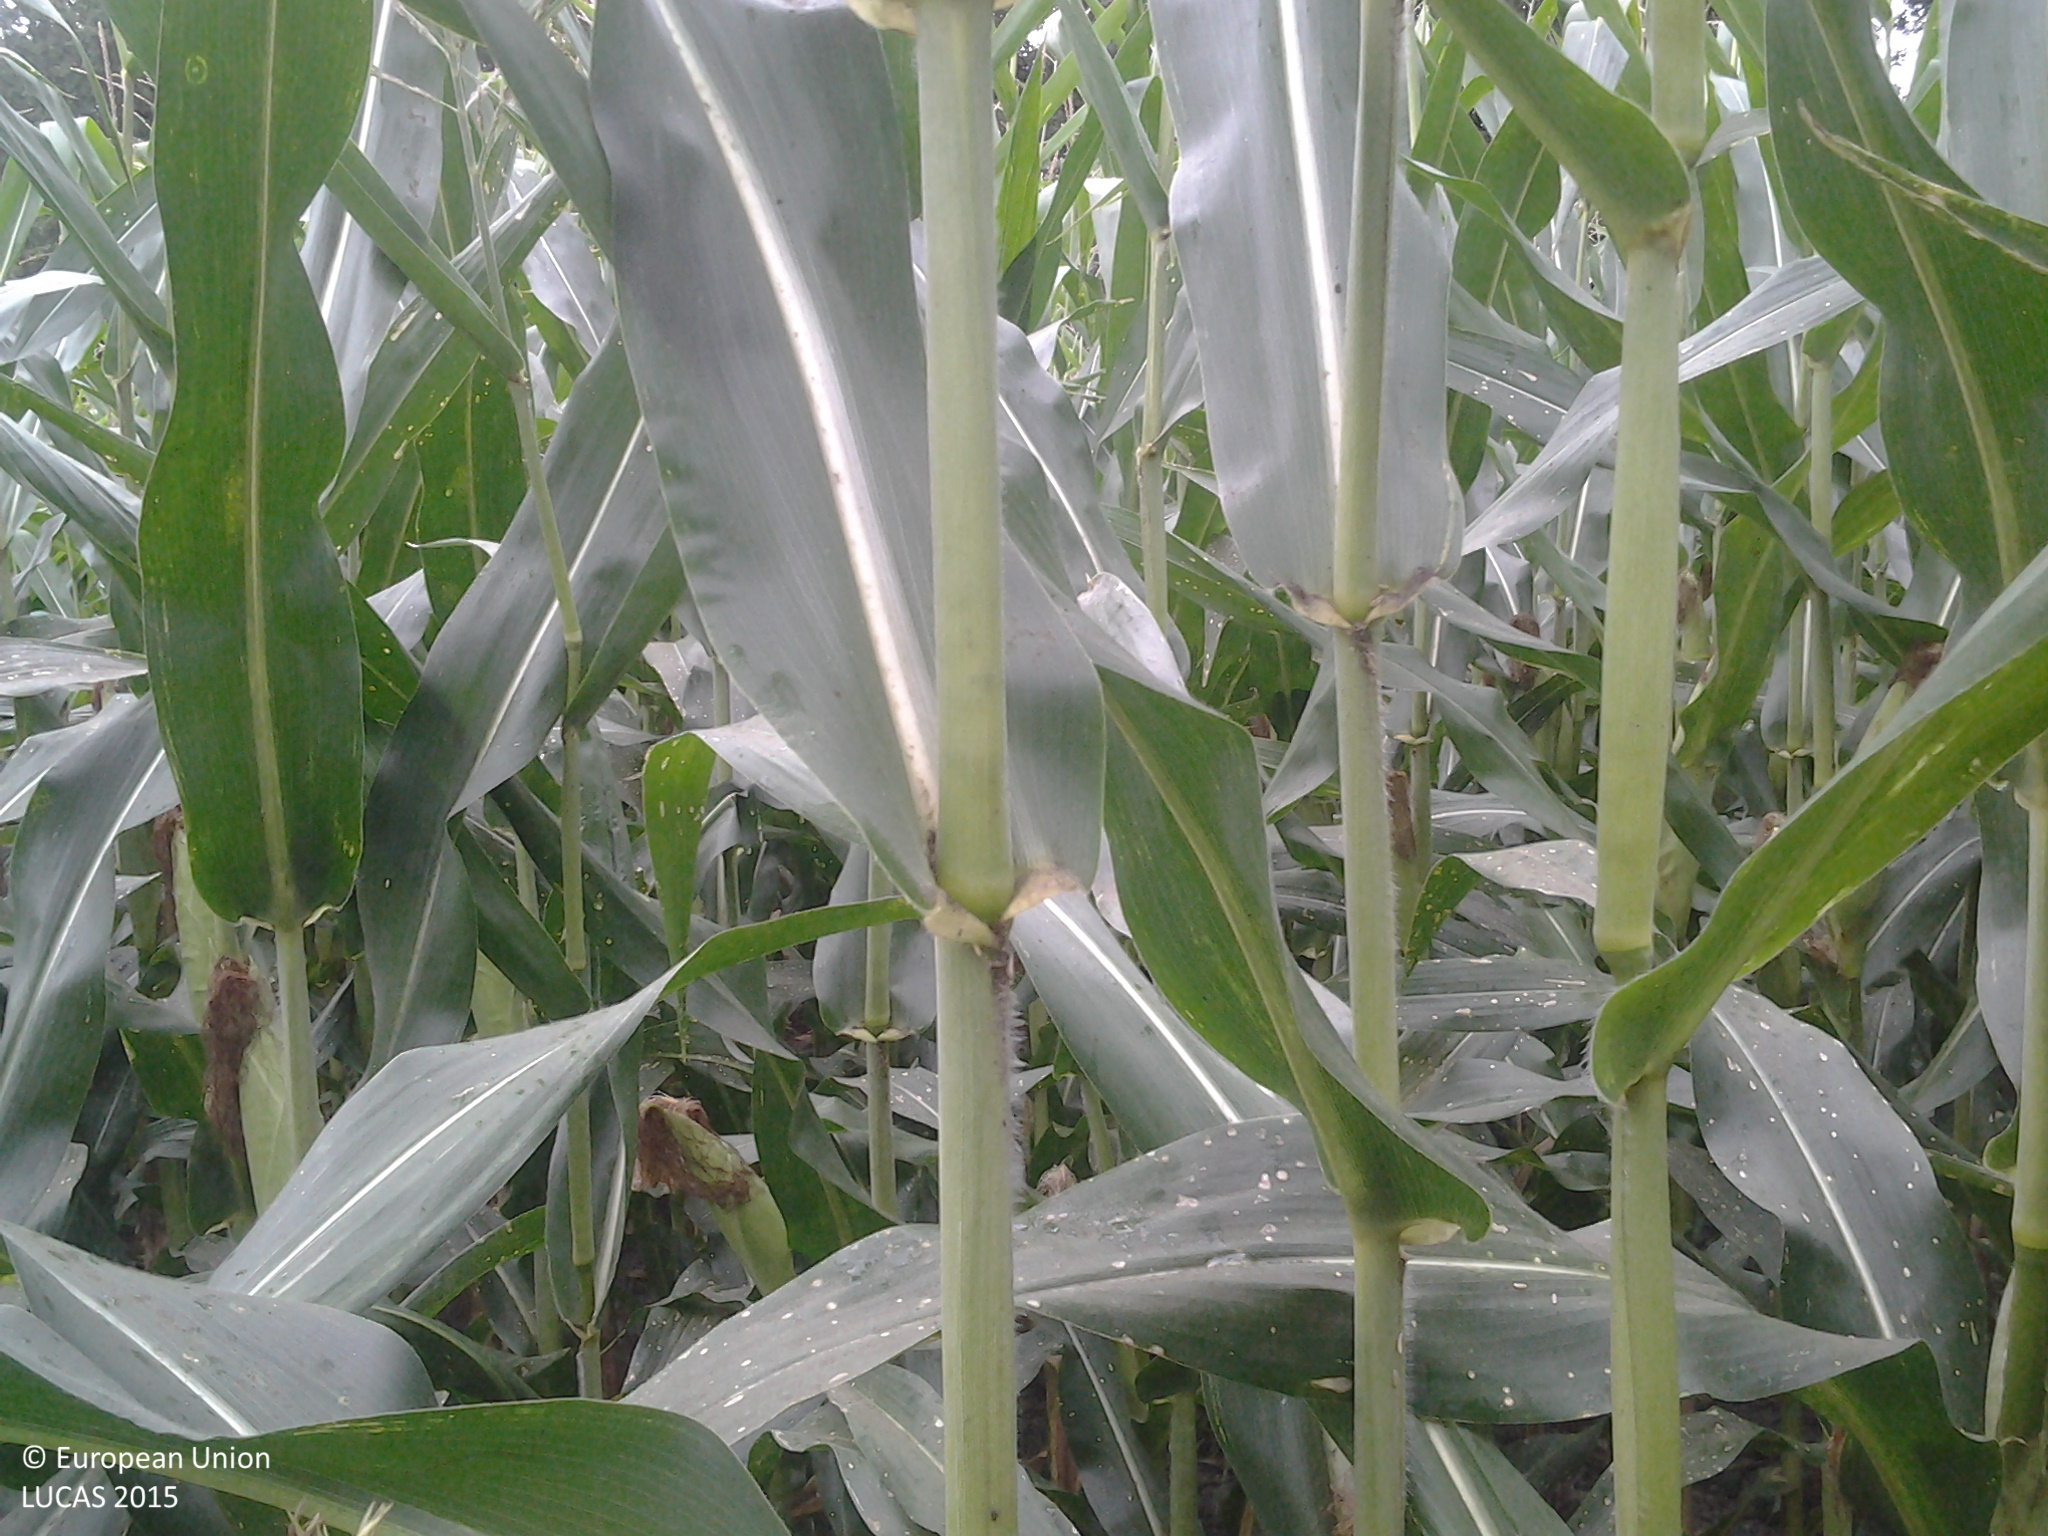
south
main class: Cropland
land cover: Maize
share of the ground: > 75 %
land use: Agriculture (excluding fallow land and kitchen gardens)
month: July
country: HU
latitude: 46.7251
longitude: 19.0825
